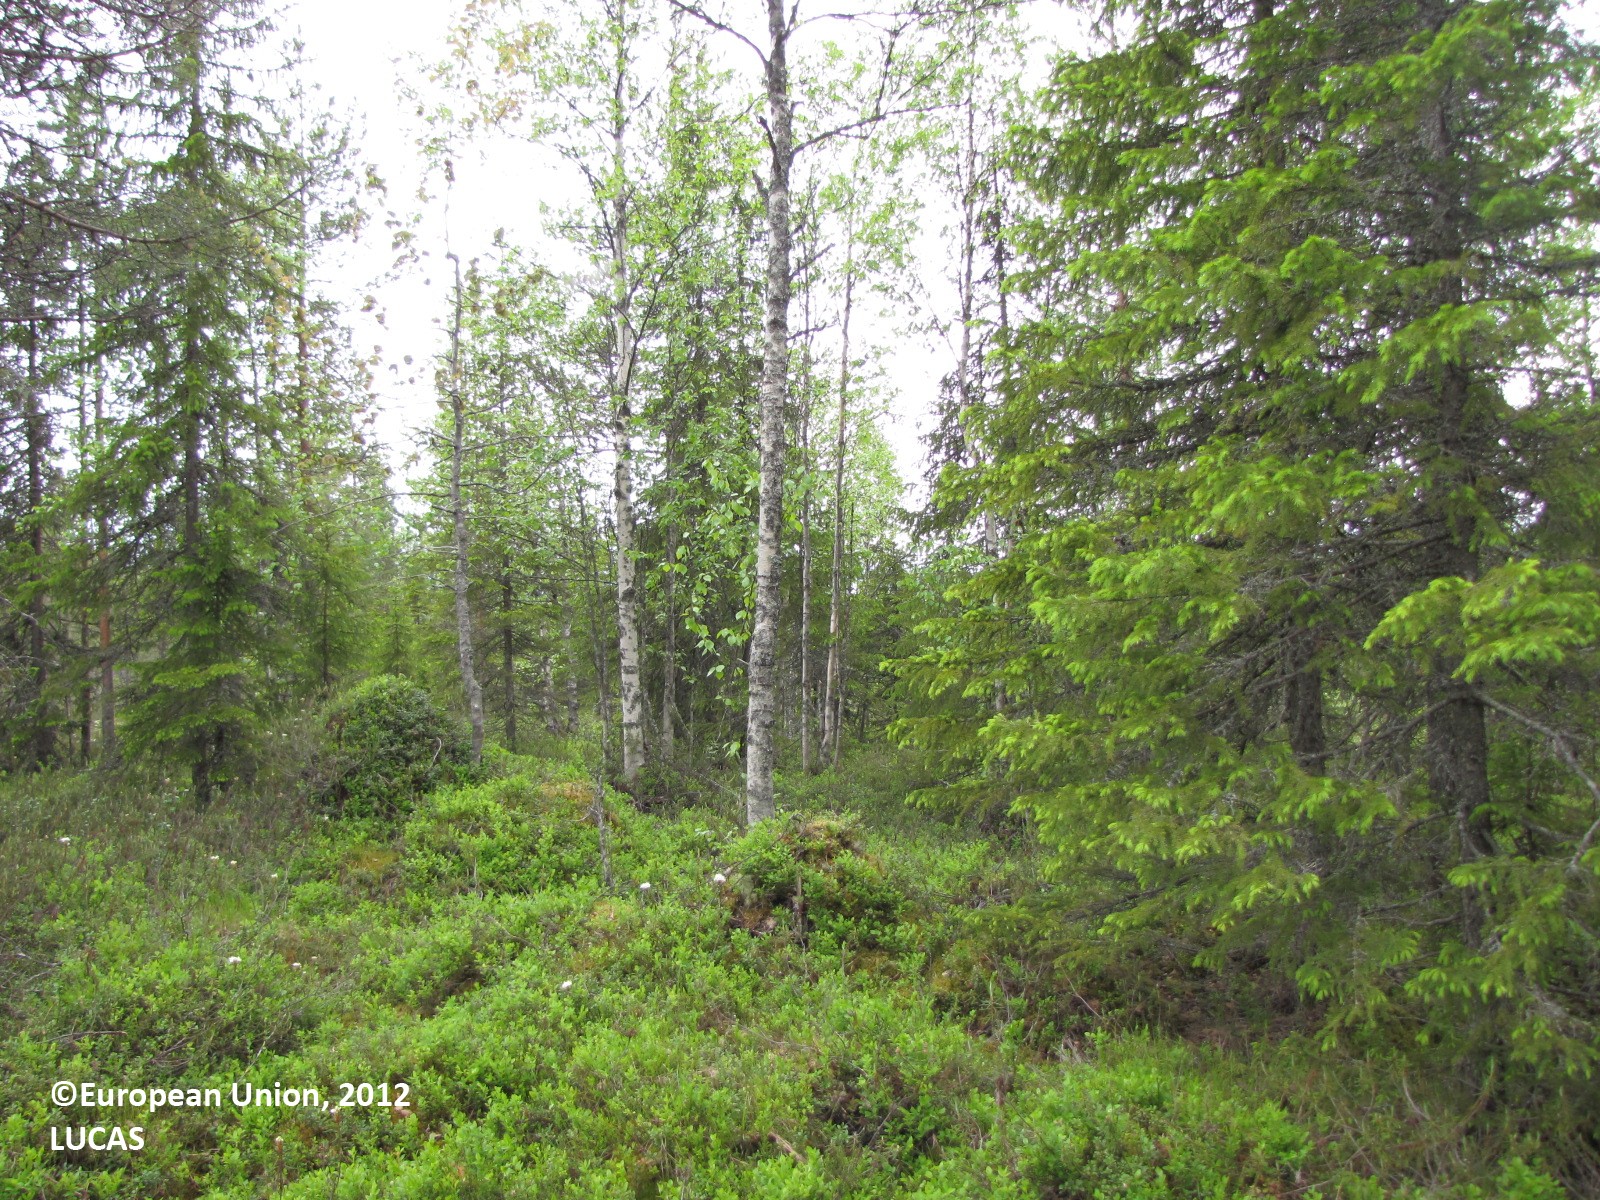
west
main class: Woodland
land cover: Other mixed woodland
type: boreal forest
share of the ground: 50 - 75 %
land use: Forestry
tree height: > 5 m
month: June
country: FI
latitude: 66.1278
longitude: 24.6902
